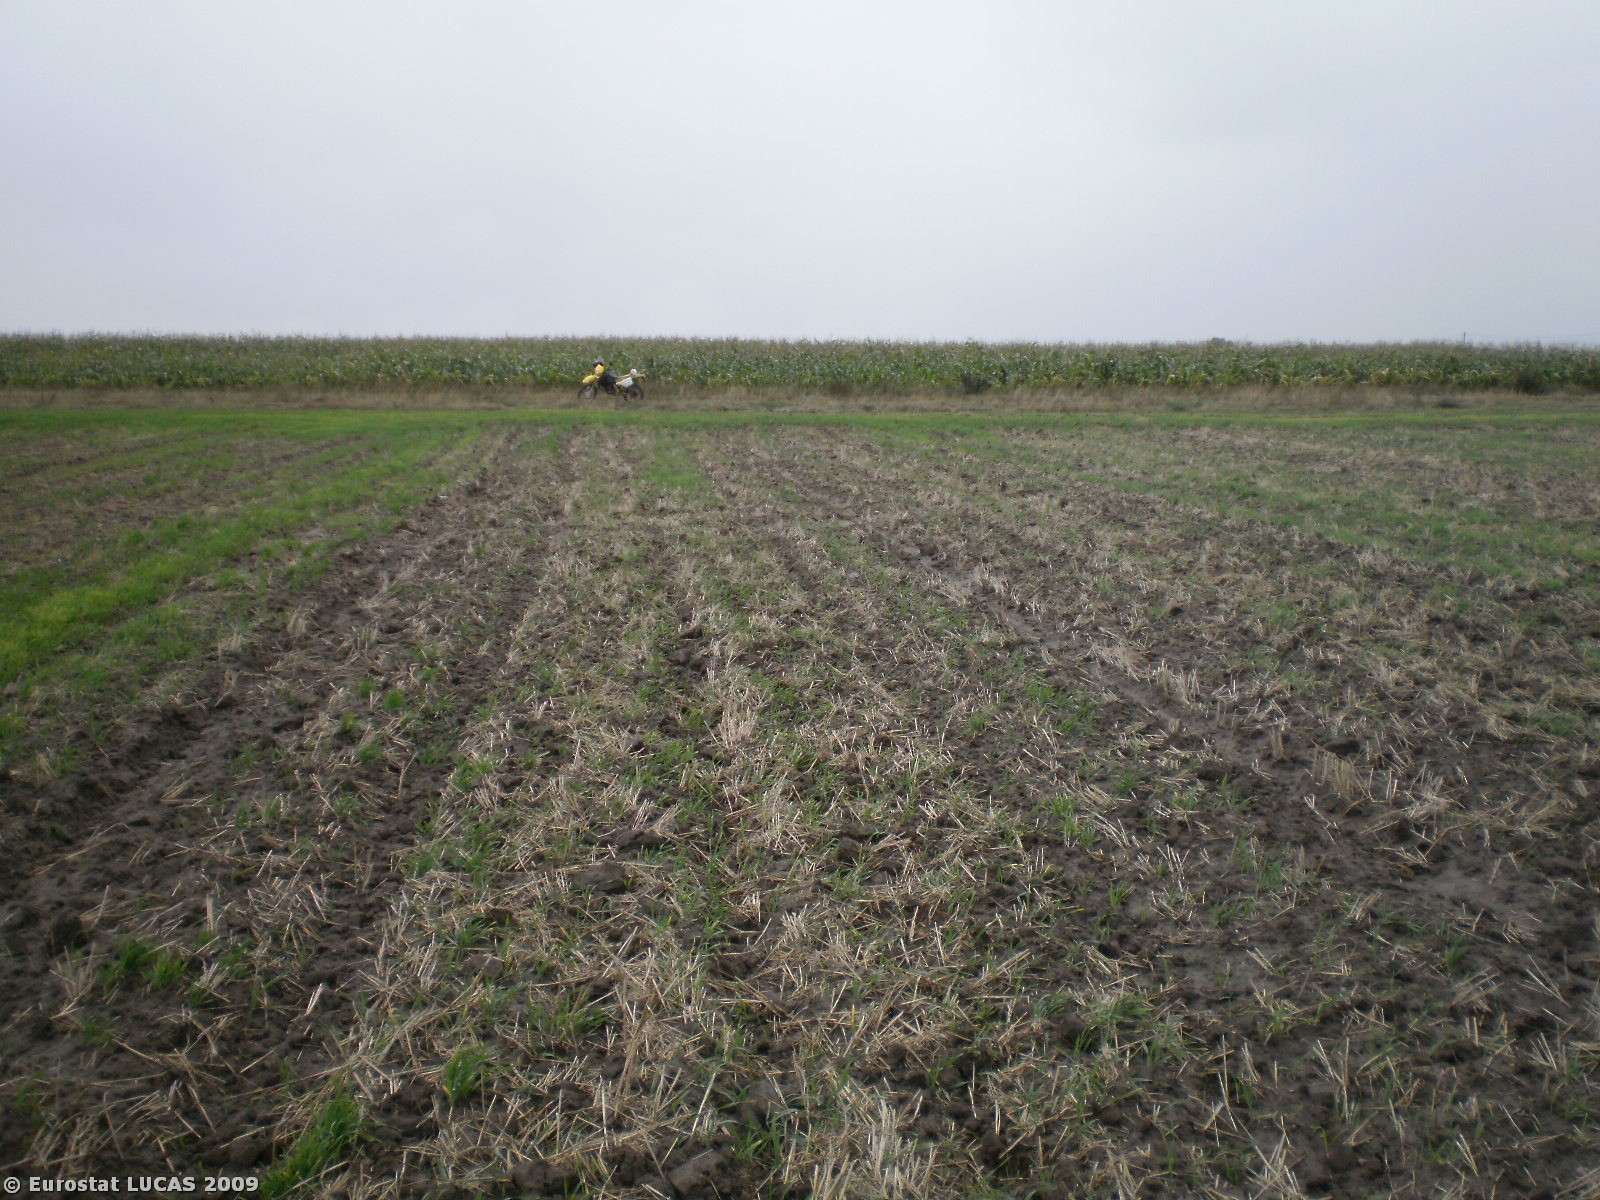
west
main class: Cropland
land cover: Barley
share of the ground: < 10 %
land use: Agriculture (excluding fallow land and kitchen gardens)
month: September
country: PL
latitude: 53.6256
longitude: 17.7090
